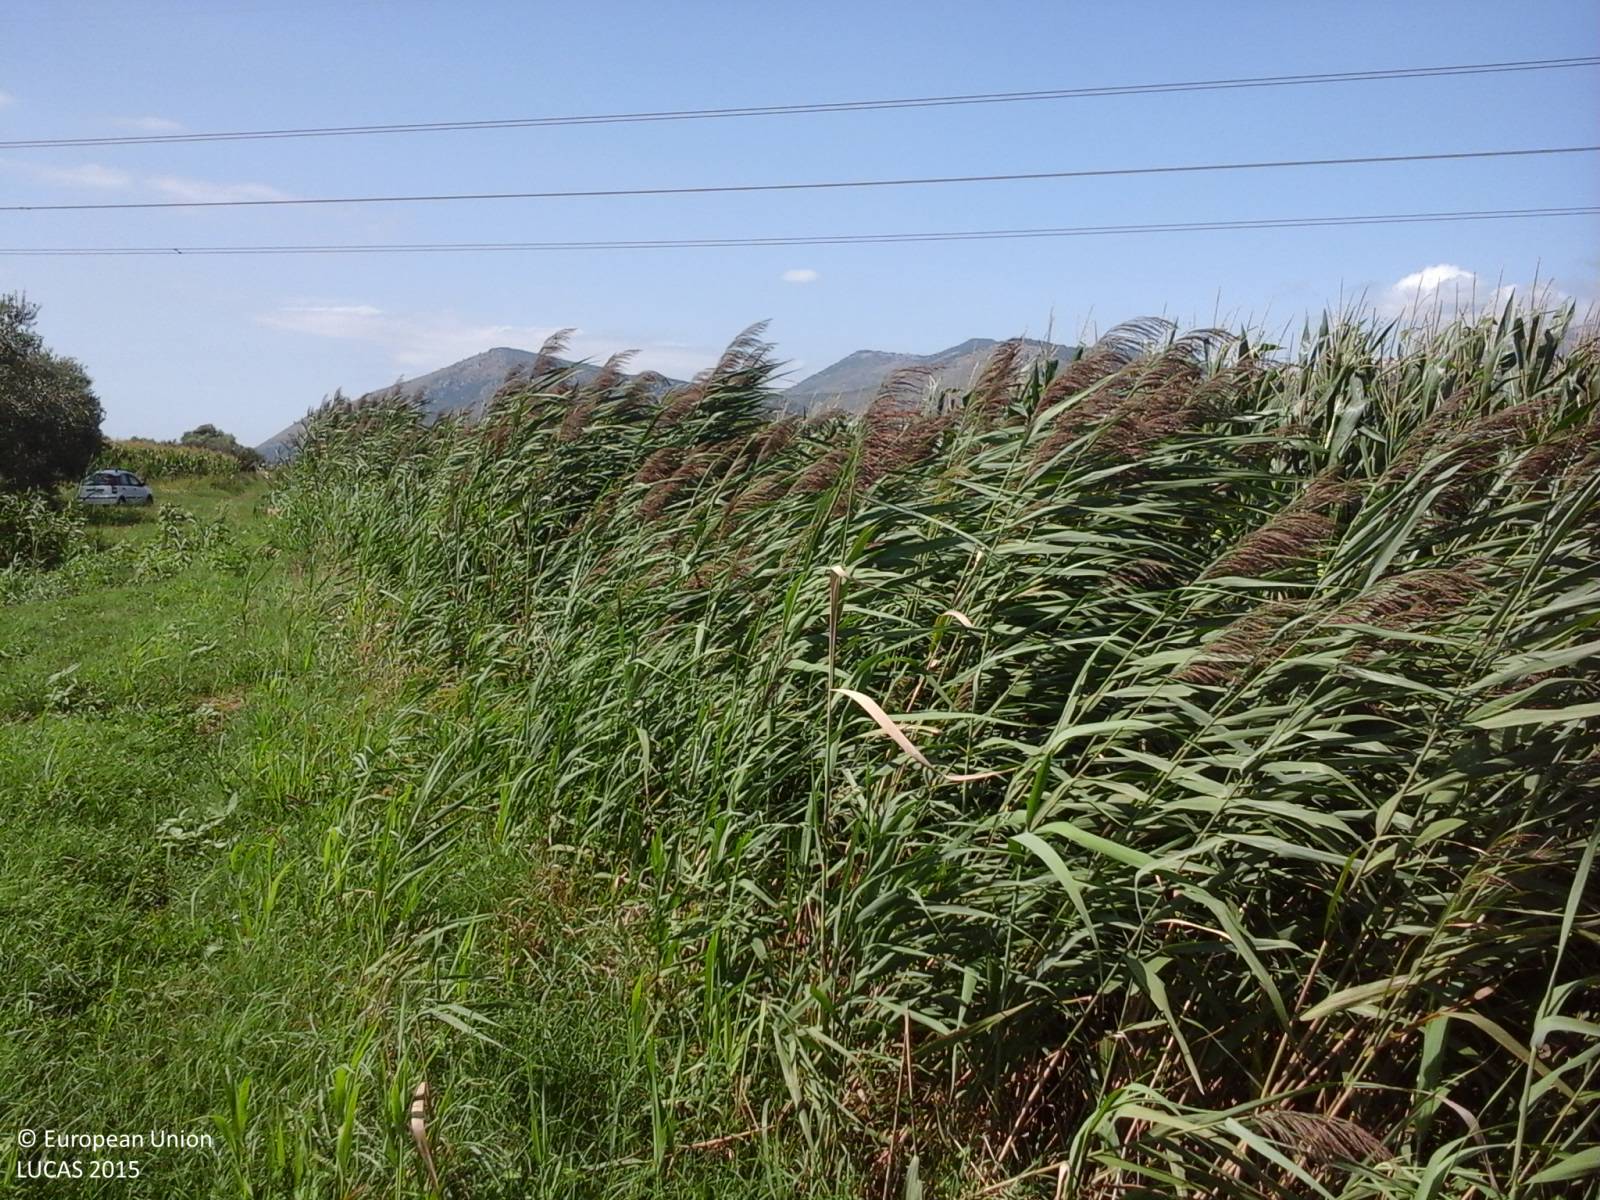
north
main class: Cropland
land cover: Maize
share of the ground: > 75 %
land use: Agriculture (excluding fallow land and kitchen gardens)
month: August
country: IT
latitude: 41.4685
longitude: 13.0651
